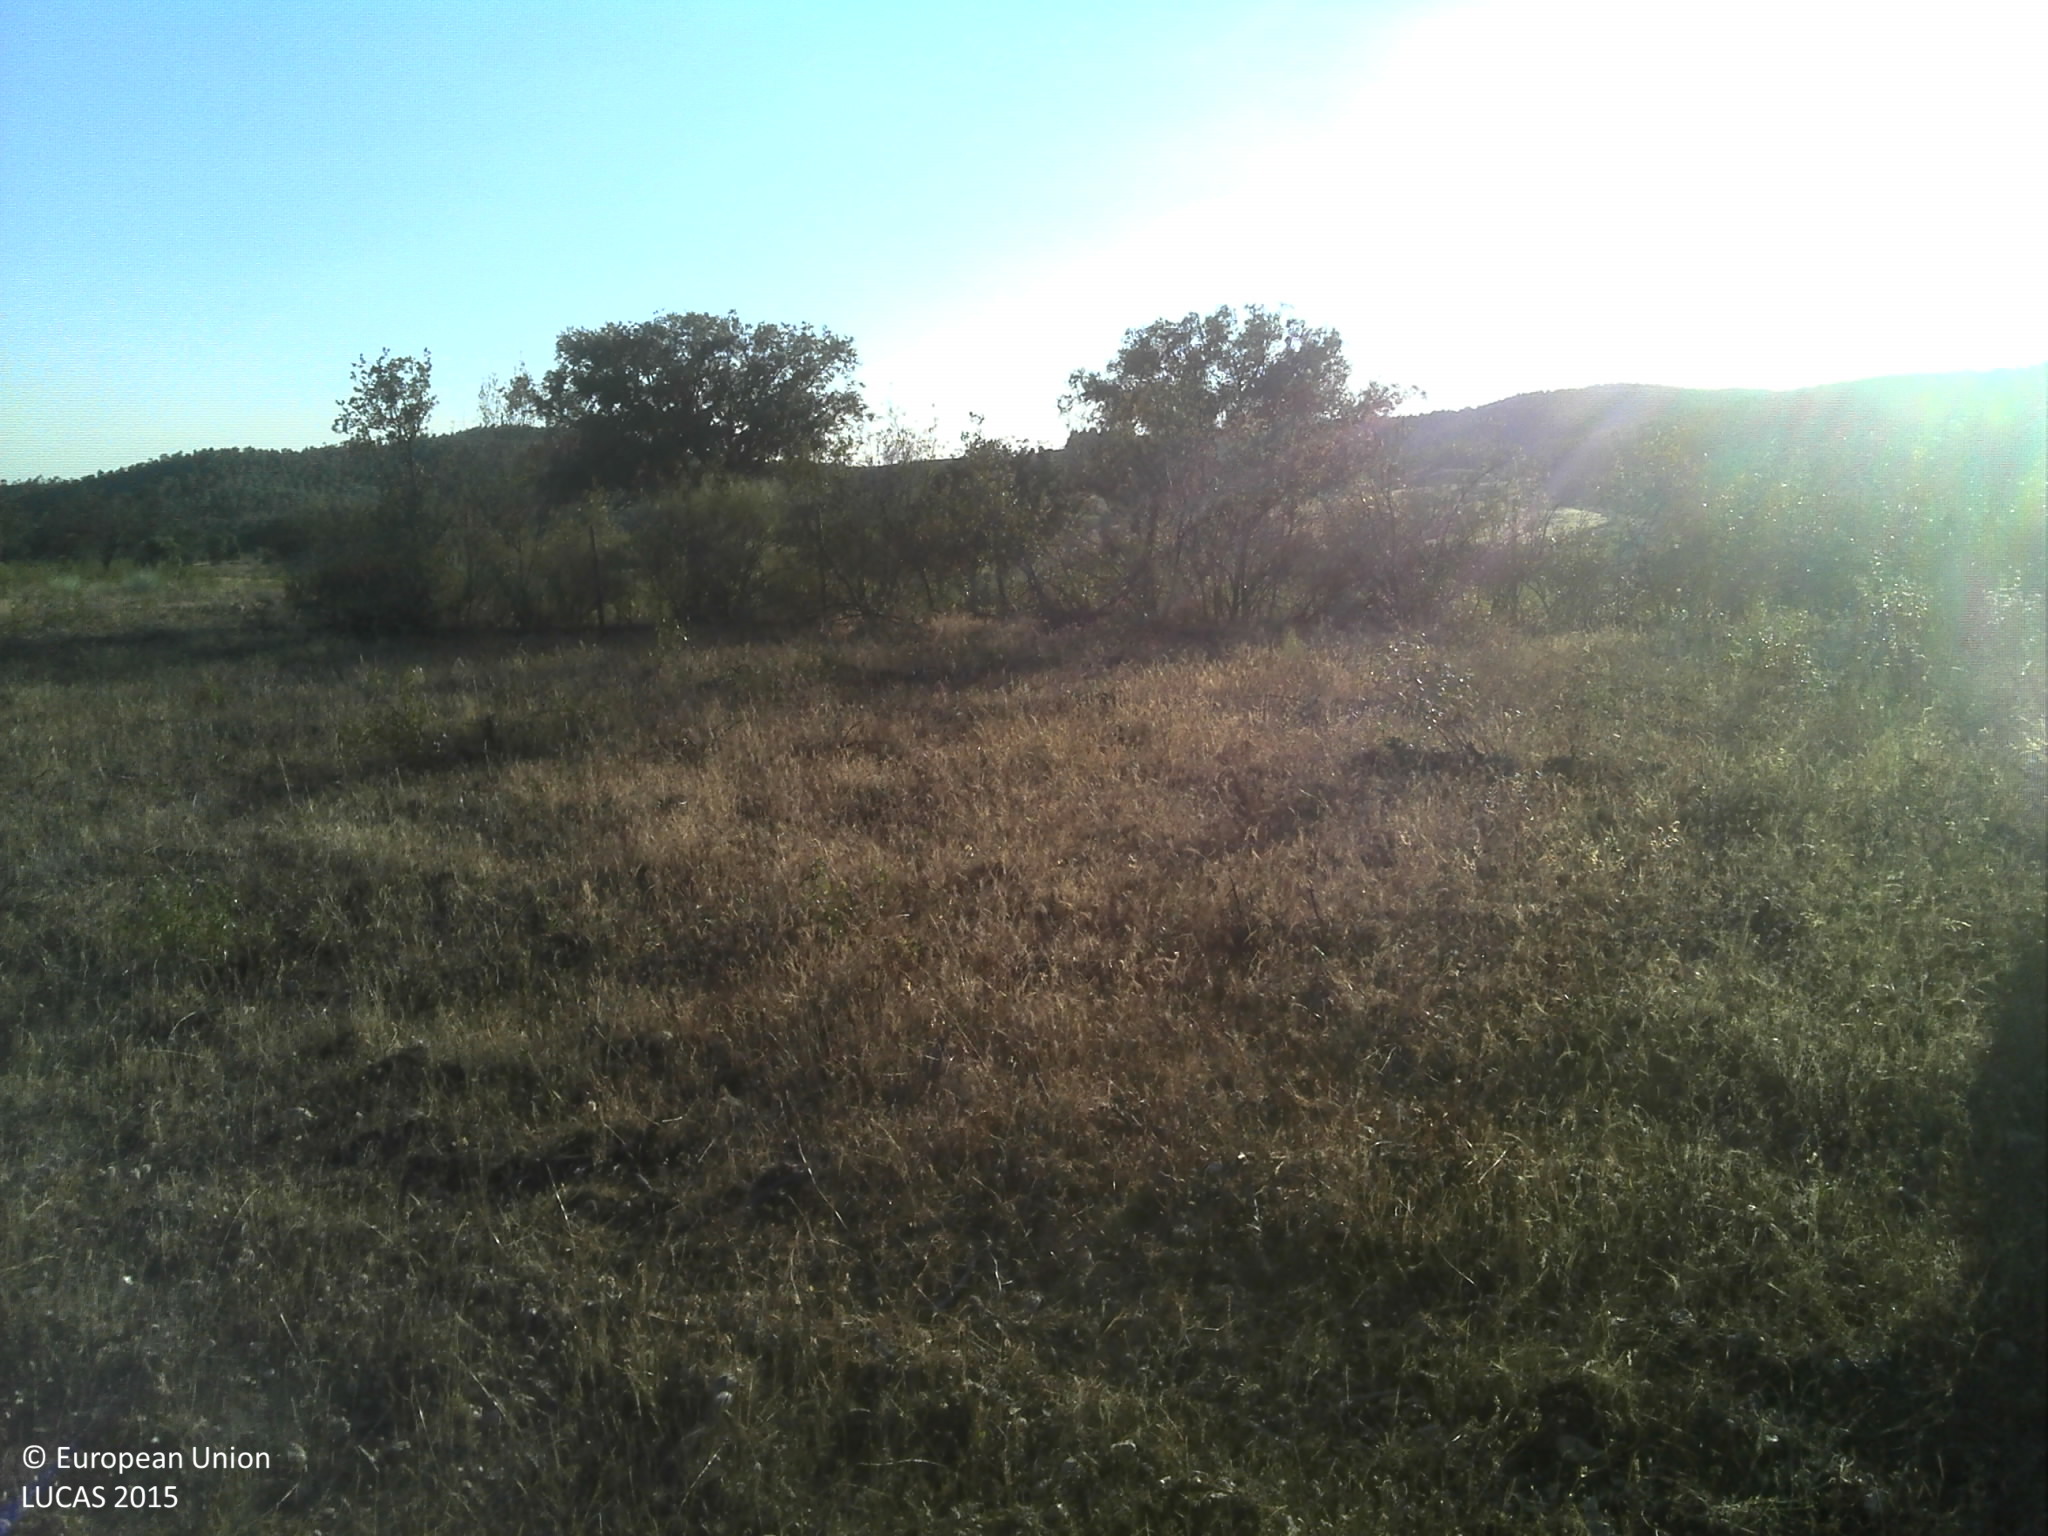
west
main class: Grassland
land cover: Grassland with sparse tree/shrub cover
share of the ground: 25 - 50 %
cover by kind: unconsolidated bare surface 45 %, herbaceous plants 40 %, broadleaved forest trees 5 %, shrubs 5 %
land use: Agriculture (excluding fallow land and kitchen gardens)
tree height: > 5 m
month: June
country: PT
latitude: 39.9388
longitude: -7.0719
